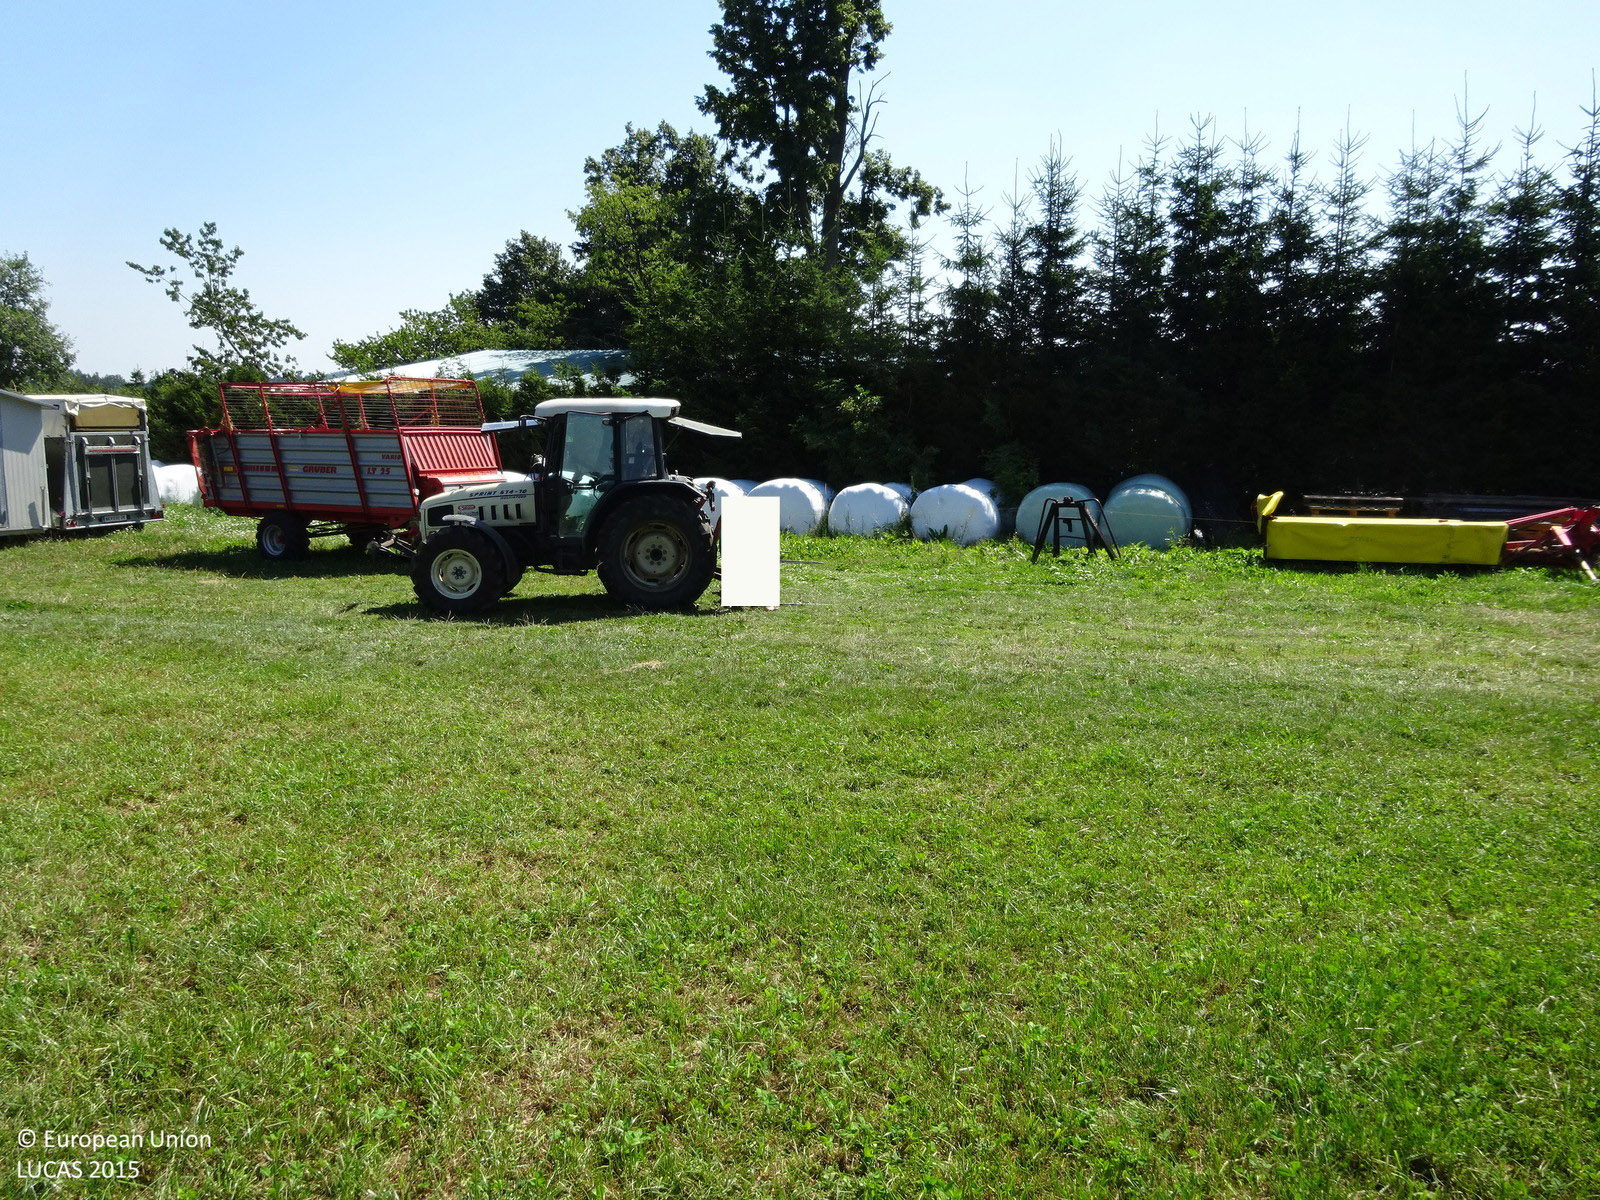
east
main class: Cropland
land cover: Temporary grasslands
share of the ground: > 75 %
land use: Agriculture (excluding fallow land and kitchen gardens)
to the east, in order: Temporary grasslands; Artificial constructions in urban areas; Common wheat; Shrubland with sparse tree cover; Grassland without tree/shrub cover; Electric lines; Broadleaved woodland; Temporary grasslands
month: August
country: AT
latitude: 47.4939
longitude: 16.1217
